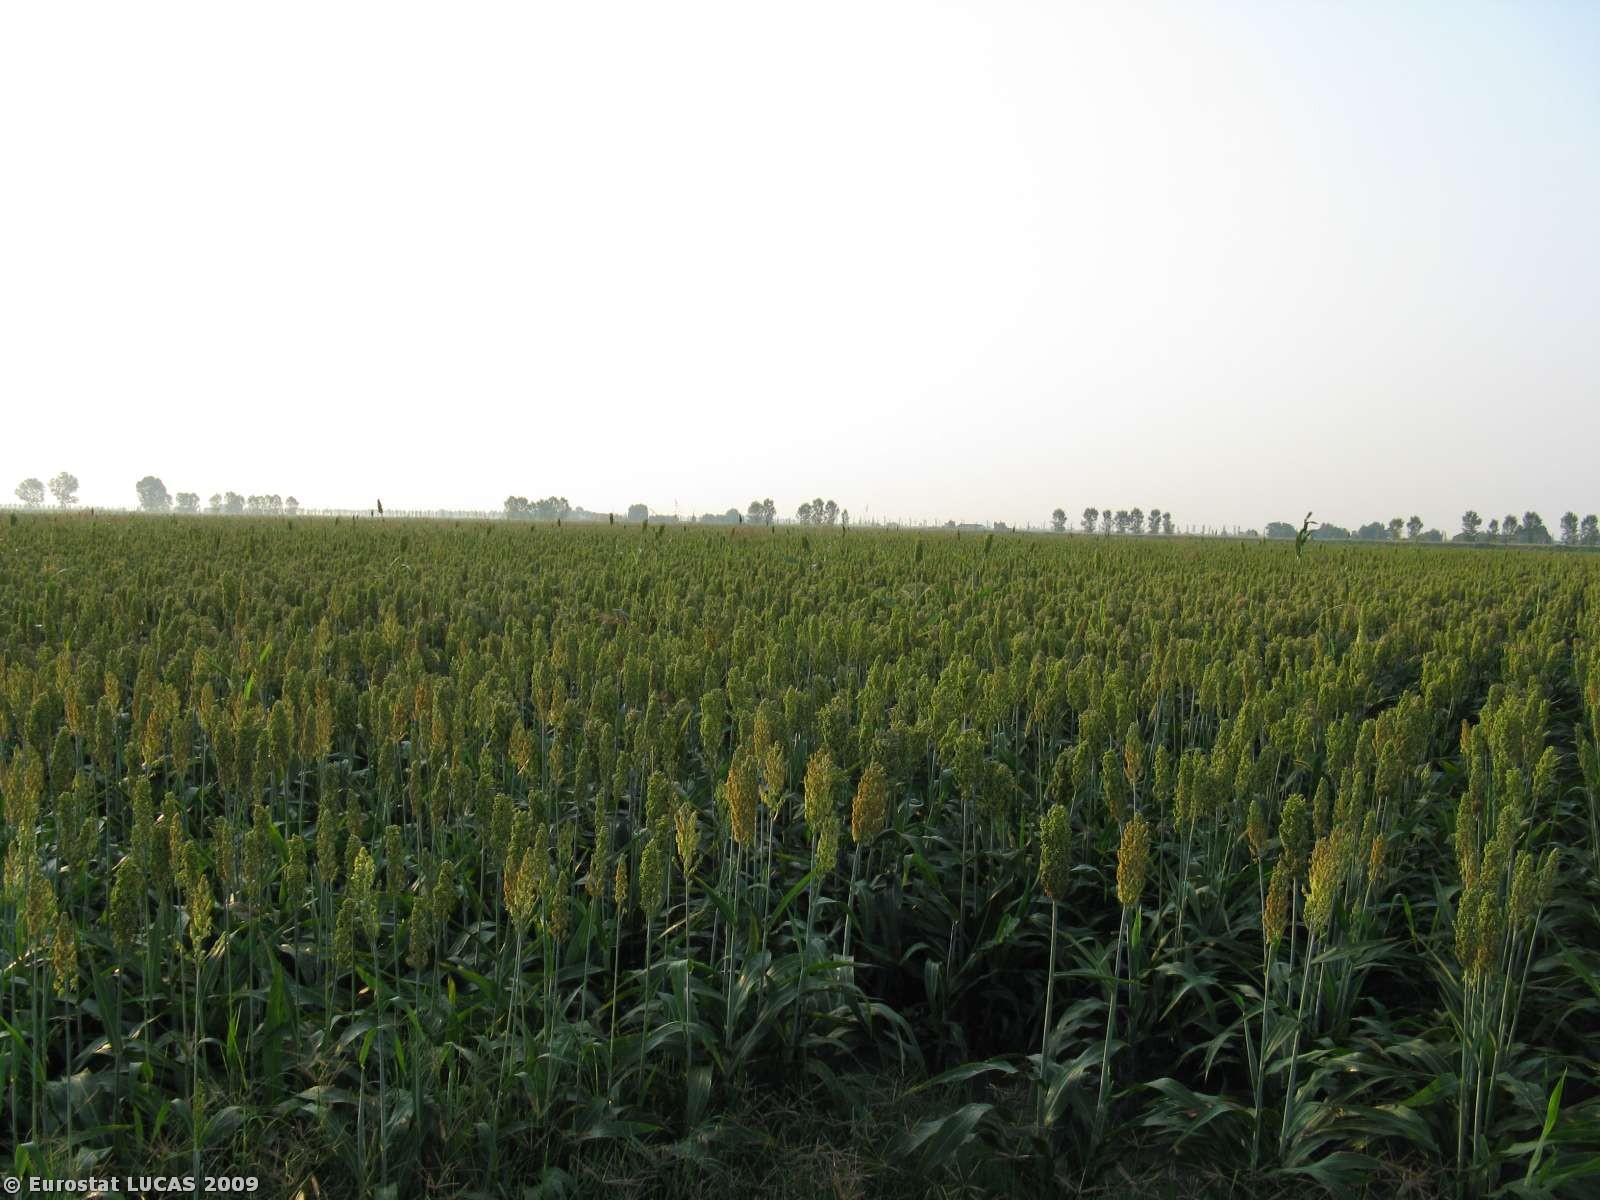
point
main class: Cropland
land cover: Other cereals
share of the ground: > 75 %
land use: Agriculture (excluding fallow land and kitchen gardens)
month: July
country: IT
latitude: 44.5708
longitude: 11.7215
